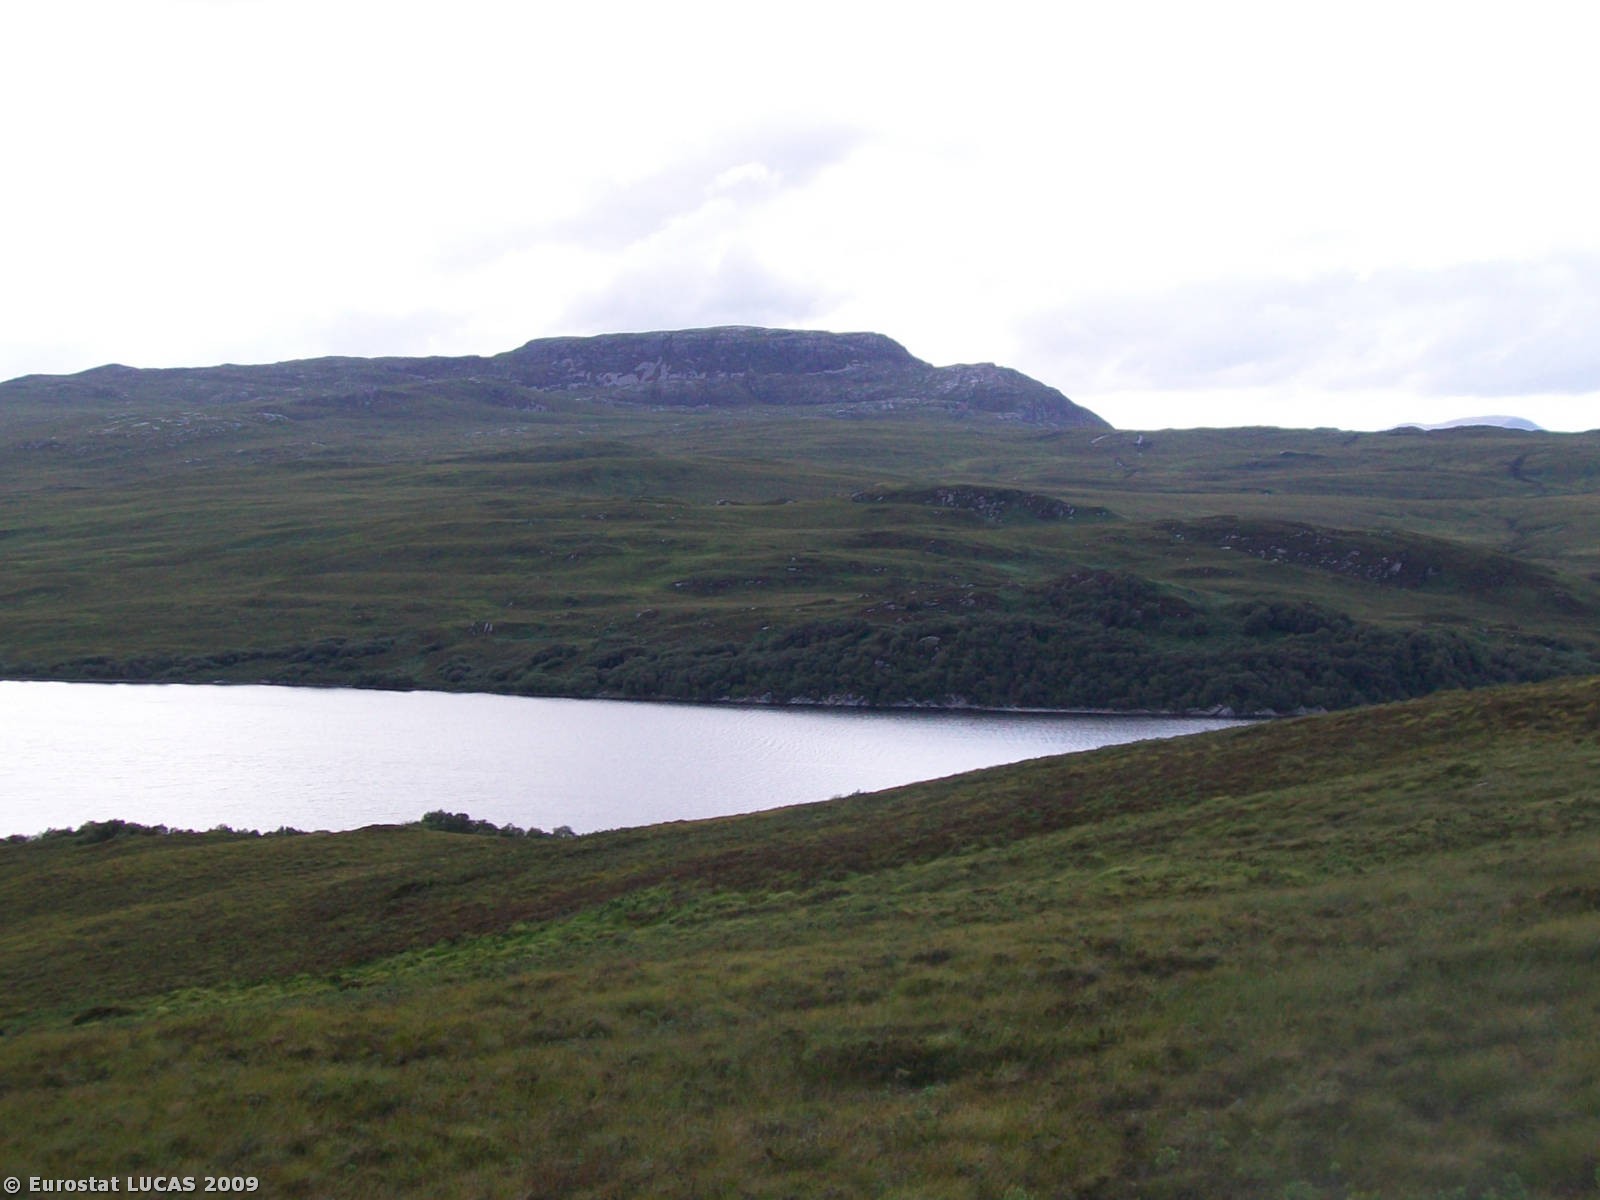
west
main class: Shrubland
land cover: Shrubland without tree cover
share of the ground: > 75 %
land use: Agriculture (excluding fallow land and kitchen gardens)
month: July
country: GB
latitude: 58.4392
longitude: -4.6314
